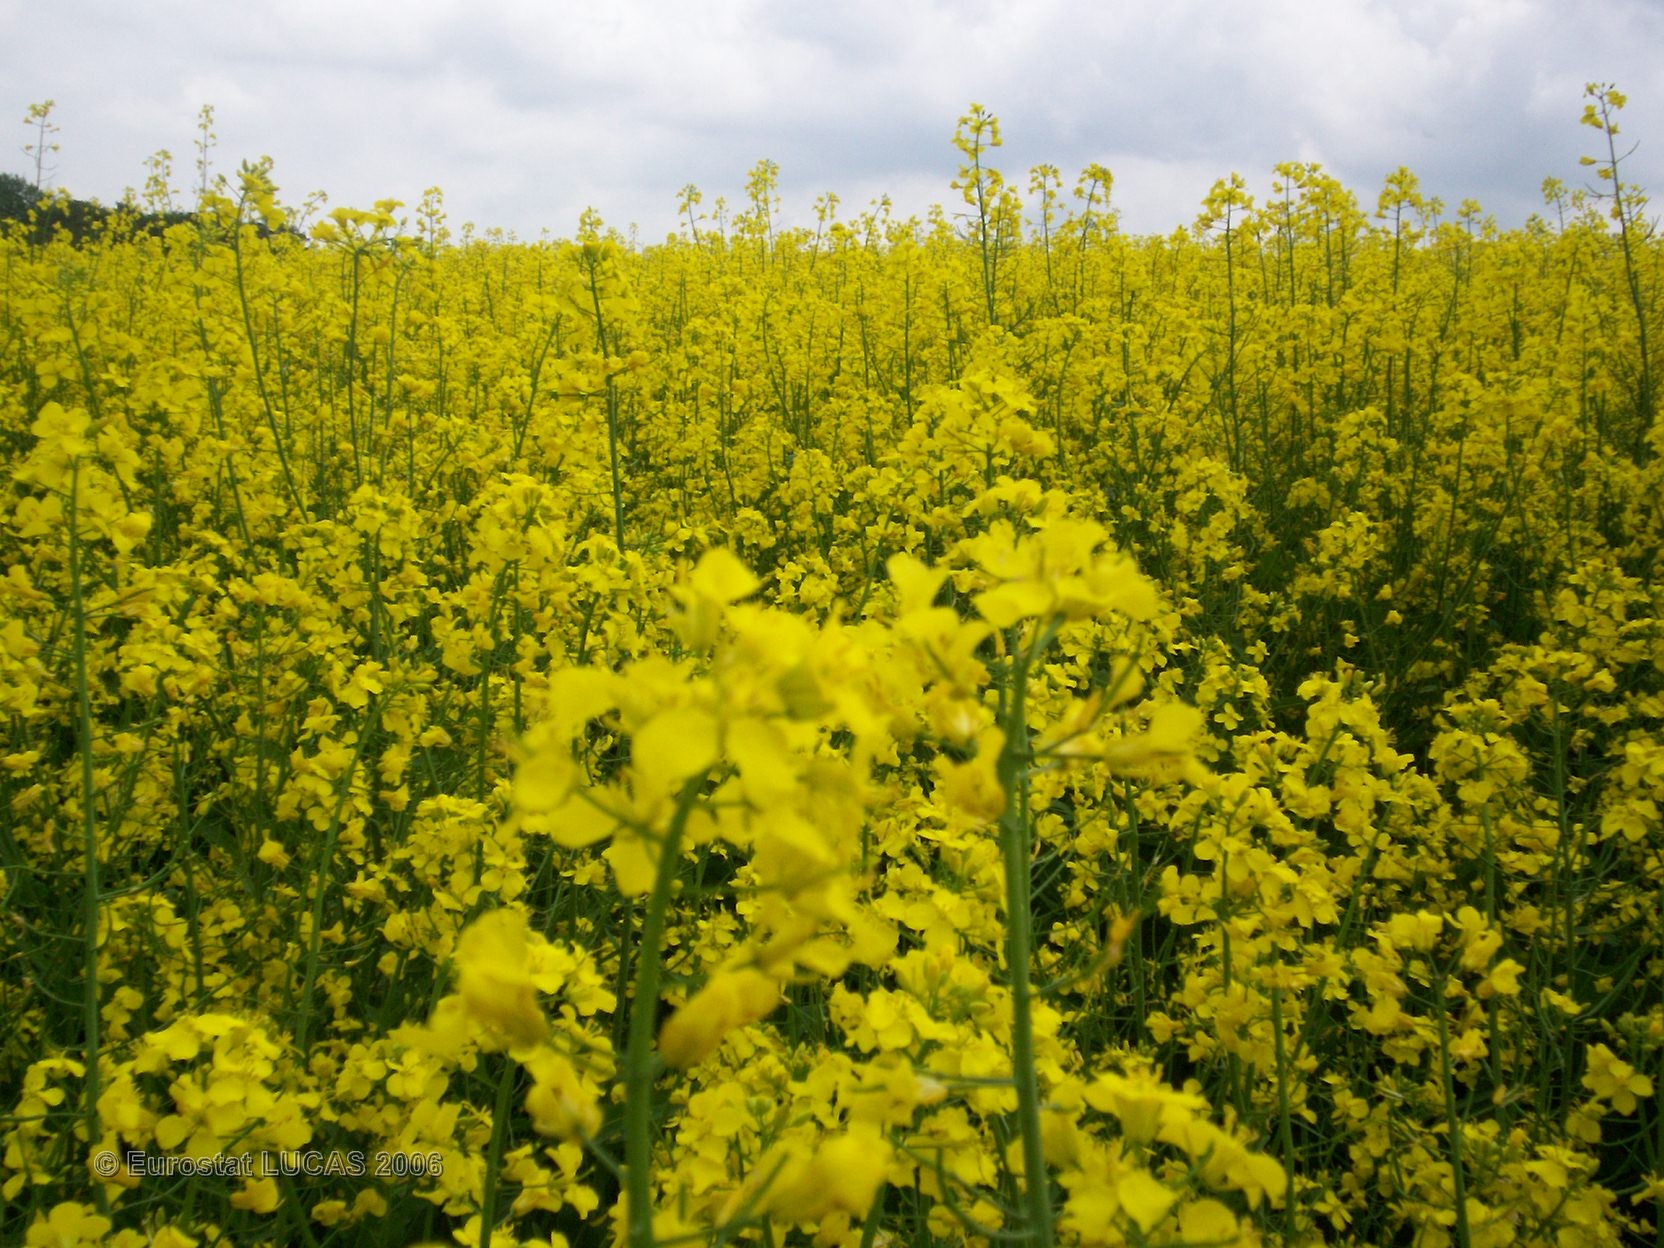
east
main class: Cropland
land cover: Rape and turnip rape
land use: Agriculture (excluding fallow land and kitchen gardens)
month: May
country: FR
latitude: 49.4074
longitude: 6.4027
